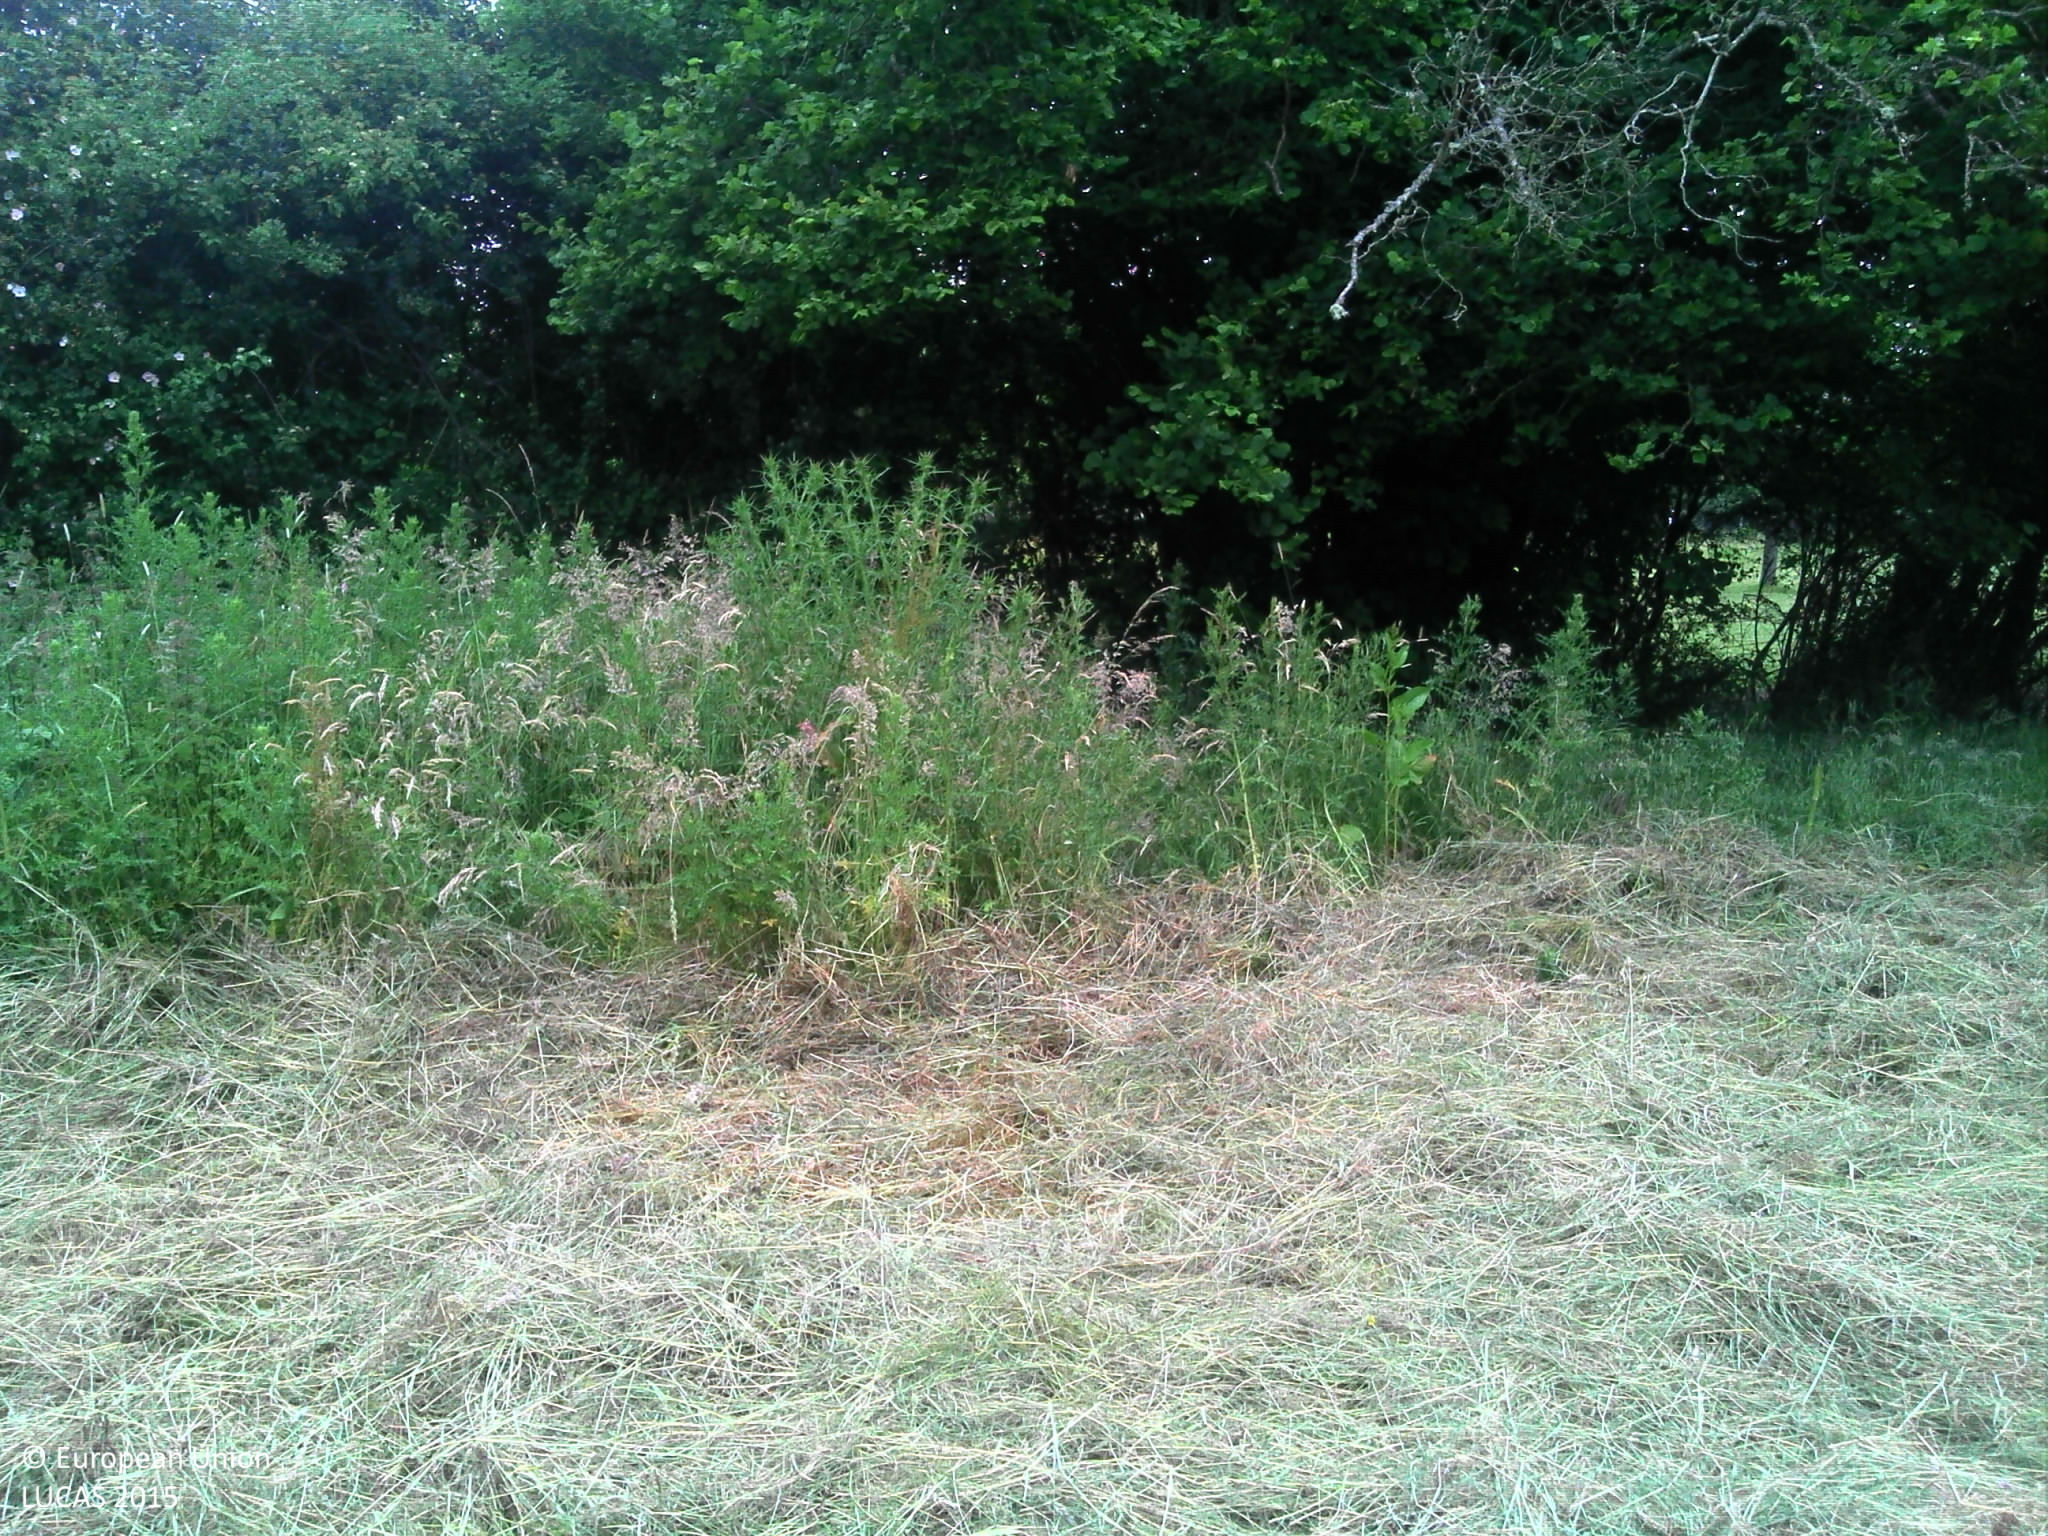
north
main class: Grassland
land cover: Grassland without tree/shrub cover
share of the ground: > 75 %
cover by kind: herbaceous plants 100 %
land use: Agriculture (excluding fallow land and kitchen gardens)
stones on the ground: < 10 %
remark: Harvested field
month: June
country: FR
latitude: 48.7541
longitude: 0.0821
